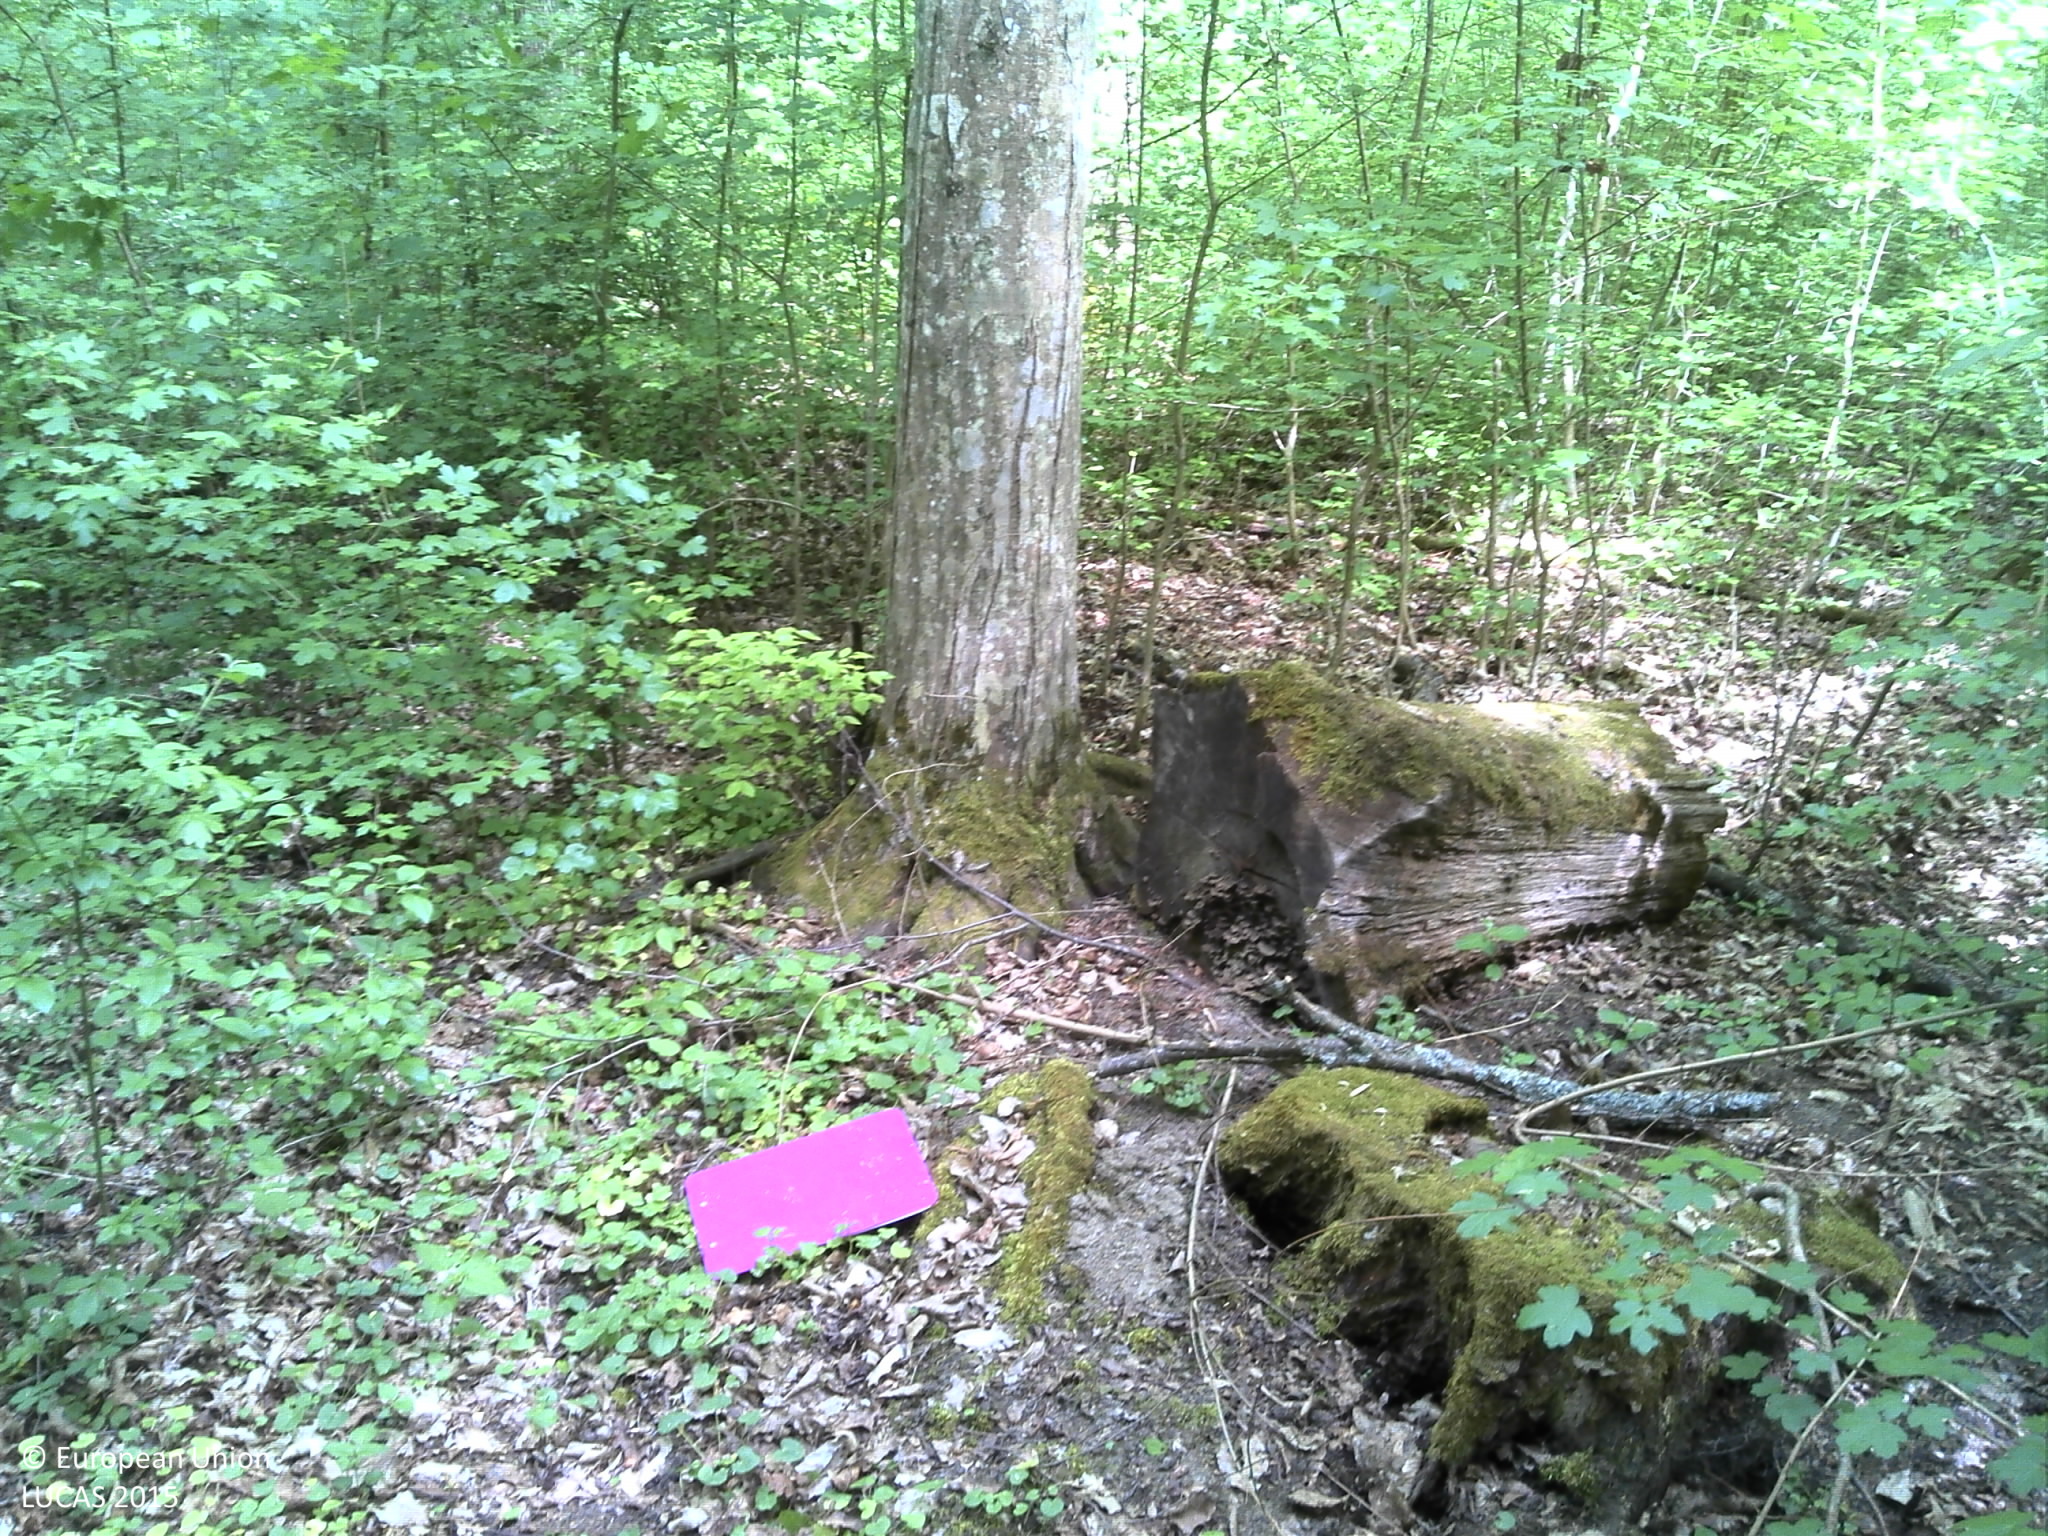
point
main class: Woodland
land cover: Broadleaved woodland
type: mesophytic deciduous forest
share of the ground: > 75 %
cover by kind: broadleaved forest trees 100 %
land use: Forestry
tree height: > 5 m
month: April
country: HR
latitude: 45.0969
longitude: 18.8381
